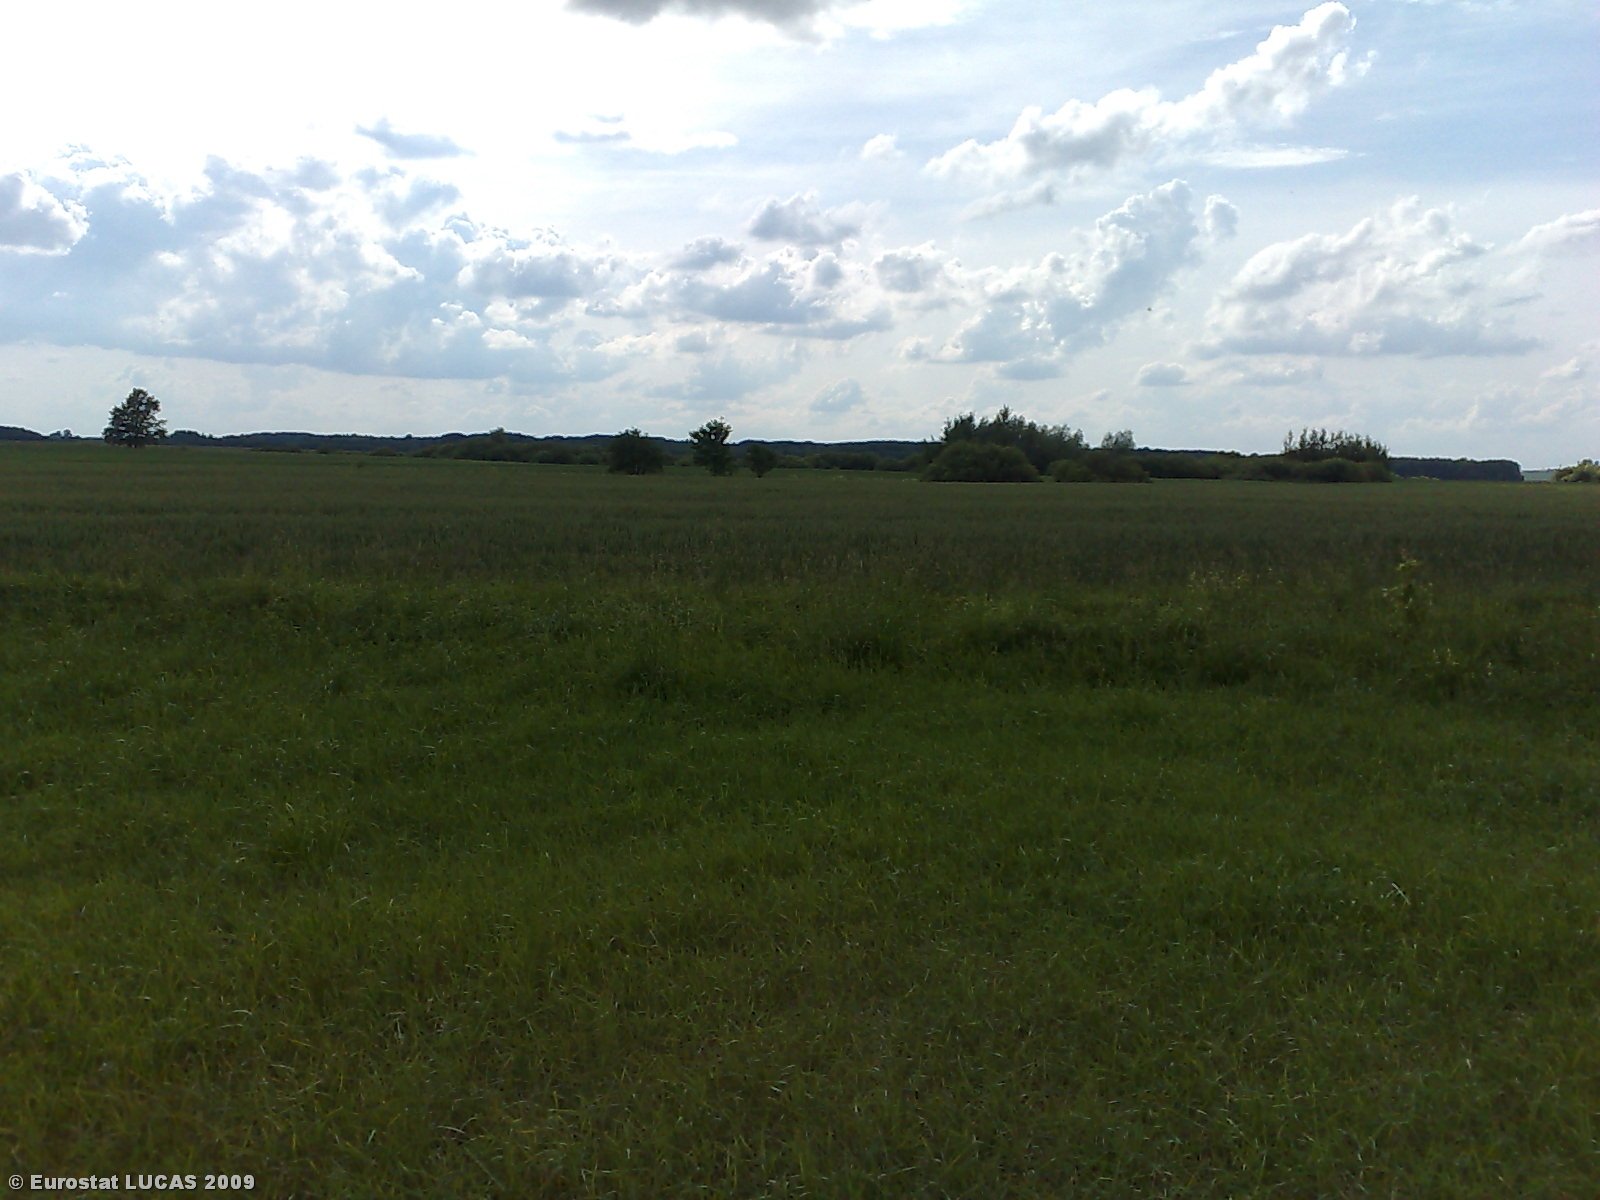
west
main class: Grassland
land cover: Grassland without tree/shrub cover
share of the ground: > 75 %
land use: Agriculture (excluding fallow land and kitchen gardens)
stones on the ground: < 10 %
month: June
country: LT
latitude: 56.0961
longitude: 24.1227
